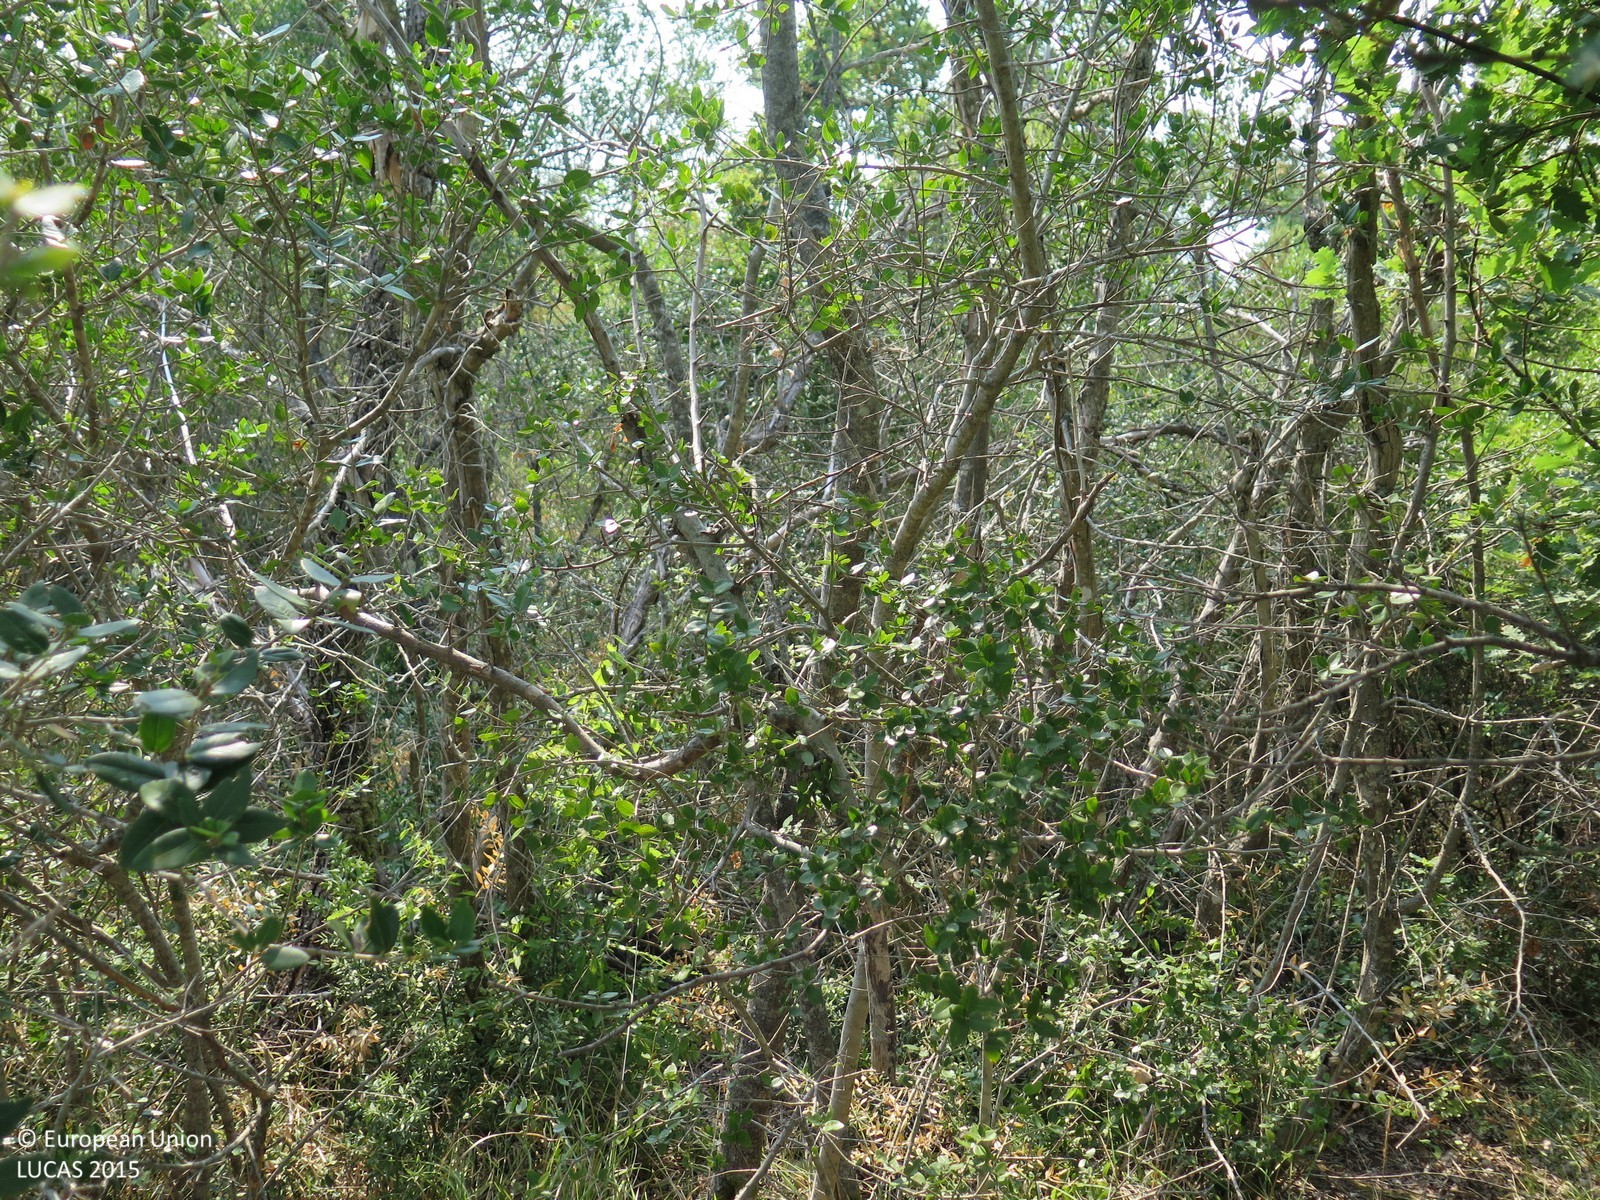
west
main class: Shrubland
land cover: Shrubland with sparse tree cover
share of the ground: > 75 %
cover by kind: shrubs 75 %, herbaceous plants 20 %, broadleaved forest trees 5 %
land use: Semi-natural and natural areas not in use
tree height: < 5 m
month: July
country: HR
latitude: 45.0044
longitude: 13.7624
